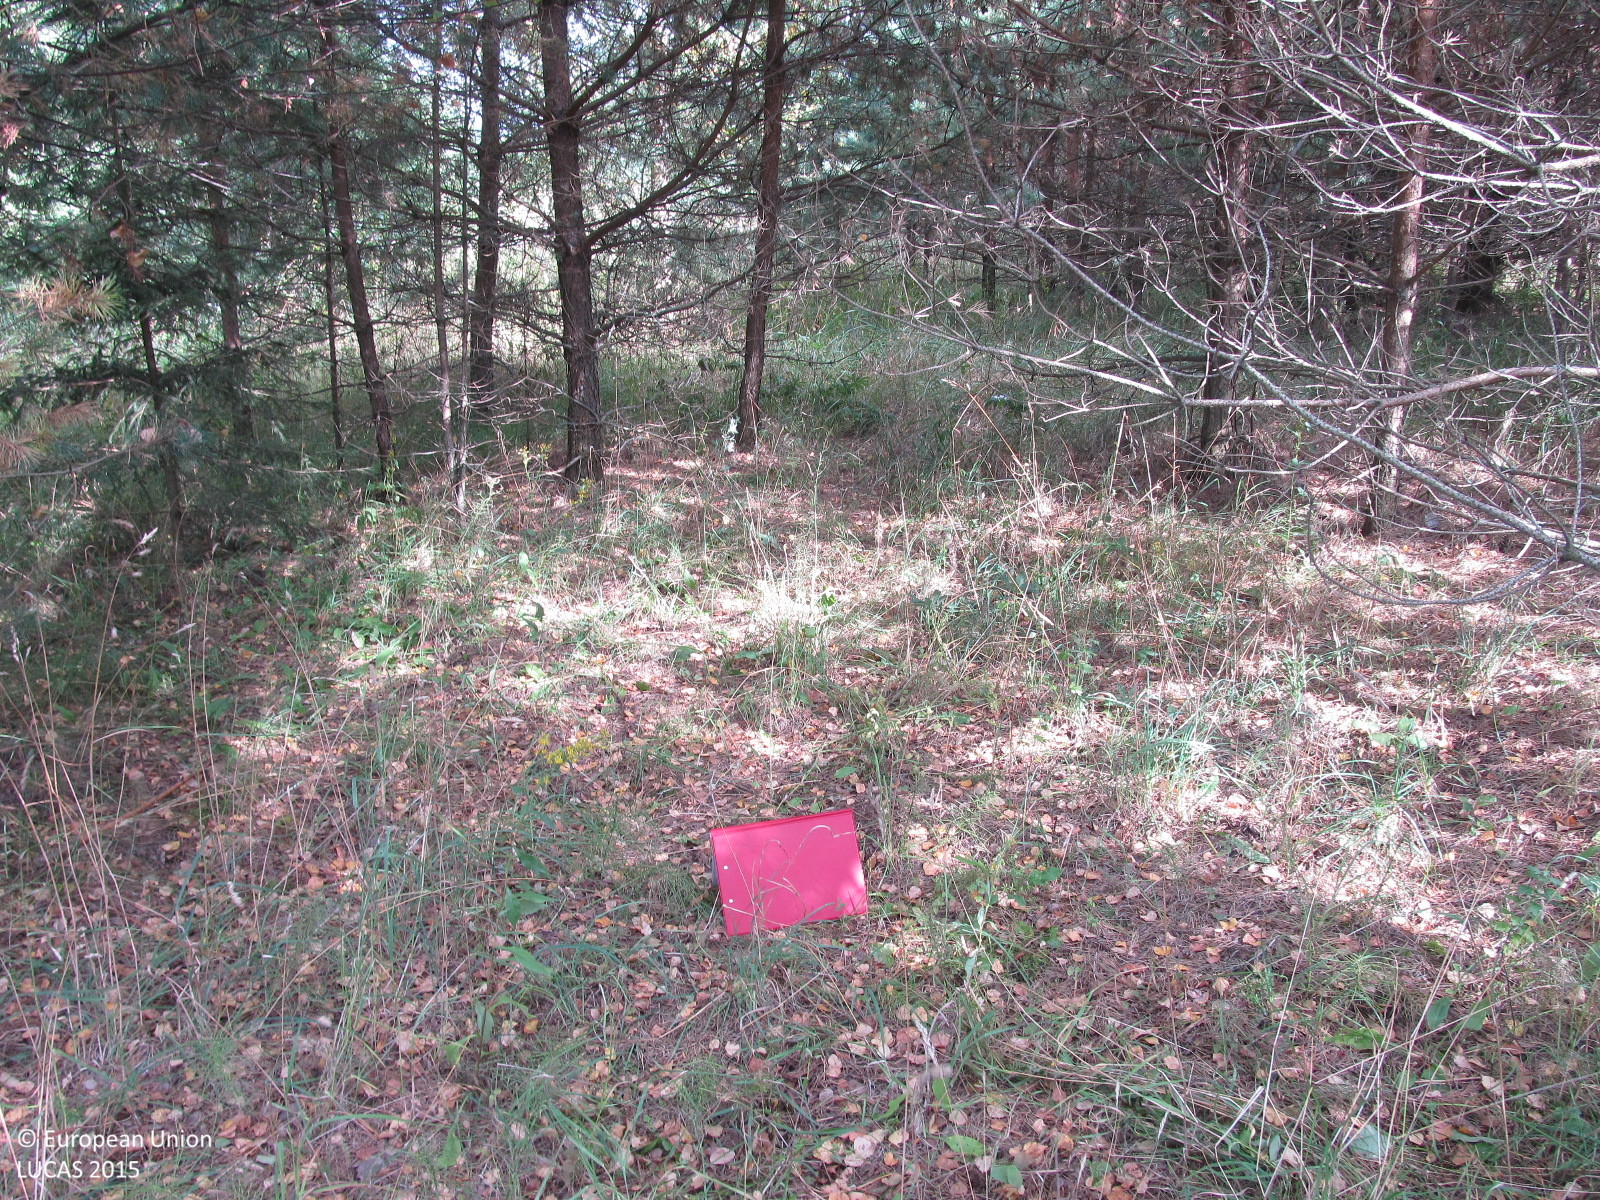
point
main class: Woodland
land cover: Pine dominated coniferous woodland
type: hemiboreal forest and nemoral coniferous forest and mixed broadleaved-coniferous forest
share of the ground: 50 - 75 %
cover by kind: coniferous forest trees 70 %, herbaceous plants 30 %
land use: Forestry
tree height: < 5 m
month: August
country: LT
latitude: 55.6756
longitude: 22.9323
